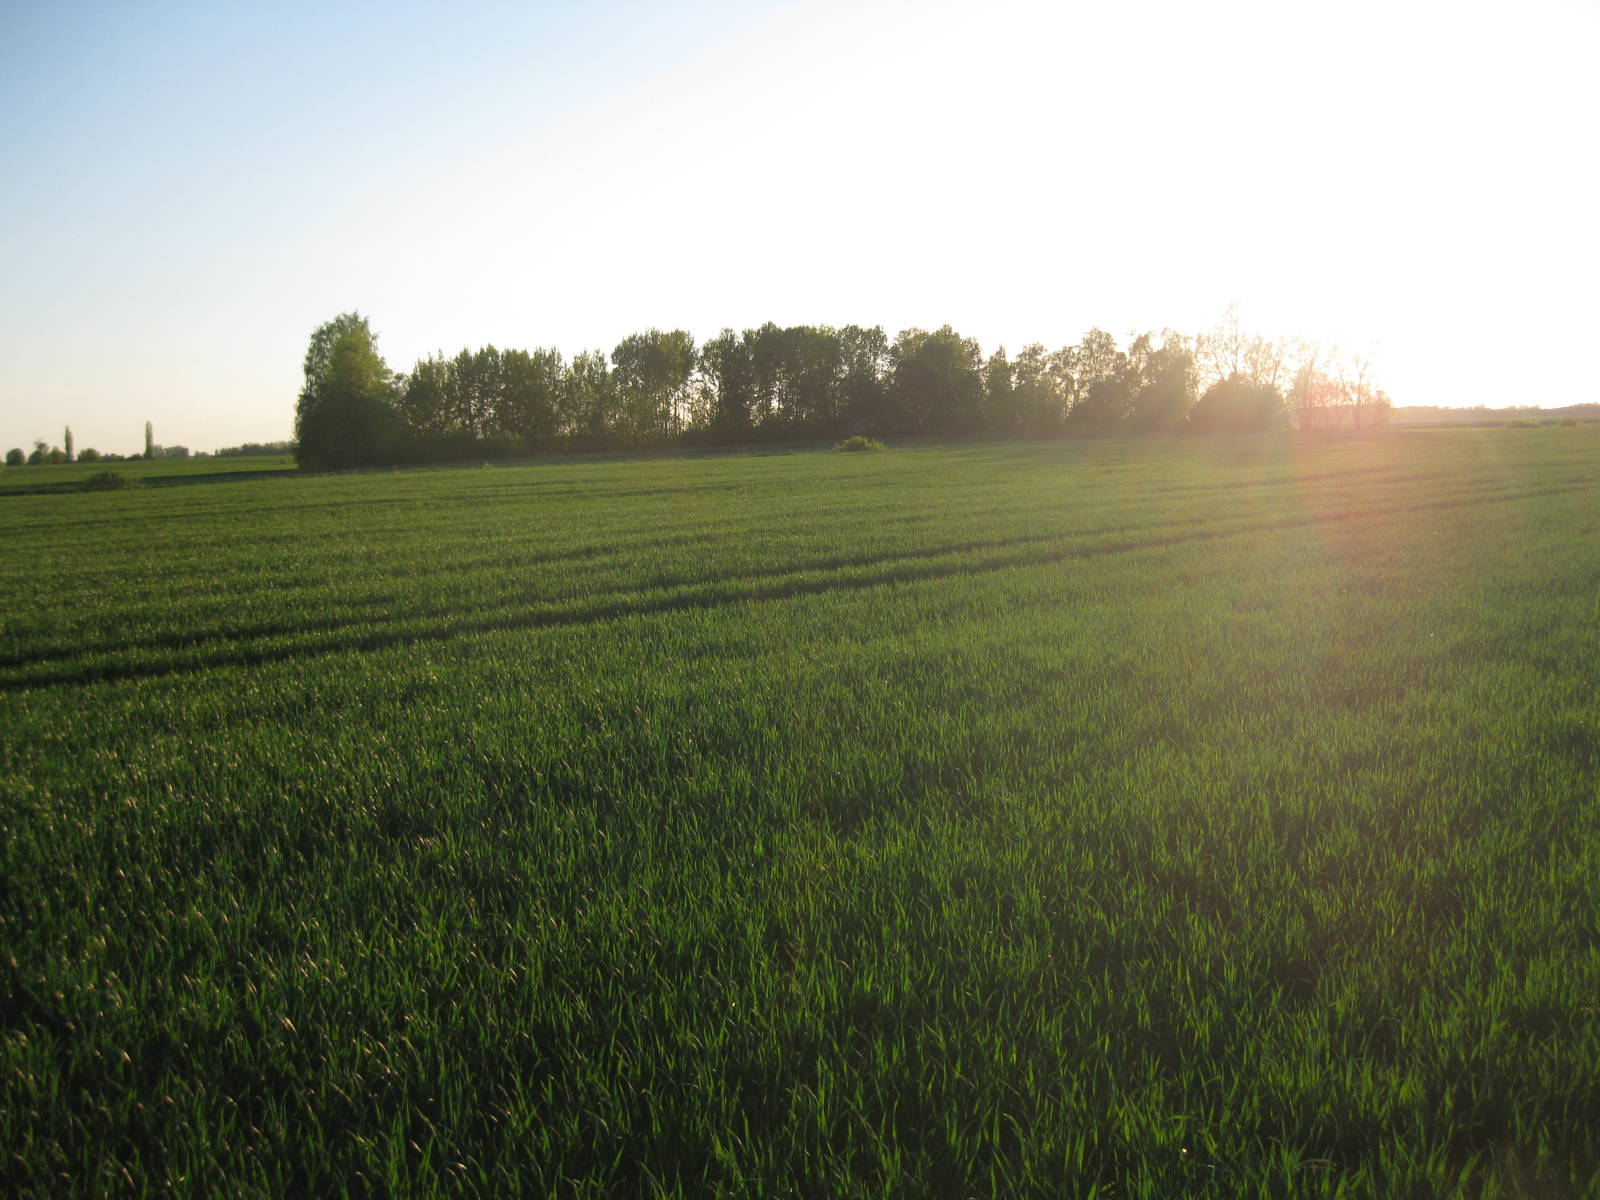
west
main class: Cropland
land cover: Common wheat
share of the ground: > 75 %
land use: Agriculture (excluding fallow land and kitchen gardens)
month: May
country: LT
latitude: 56.0993
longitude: 24.4197
